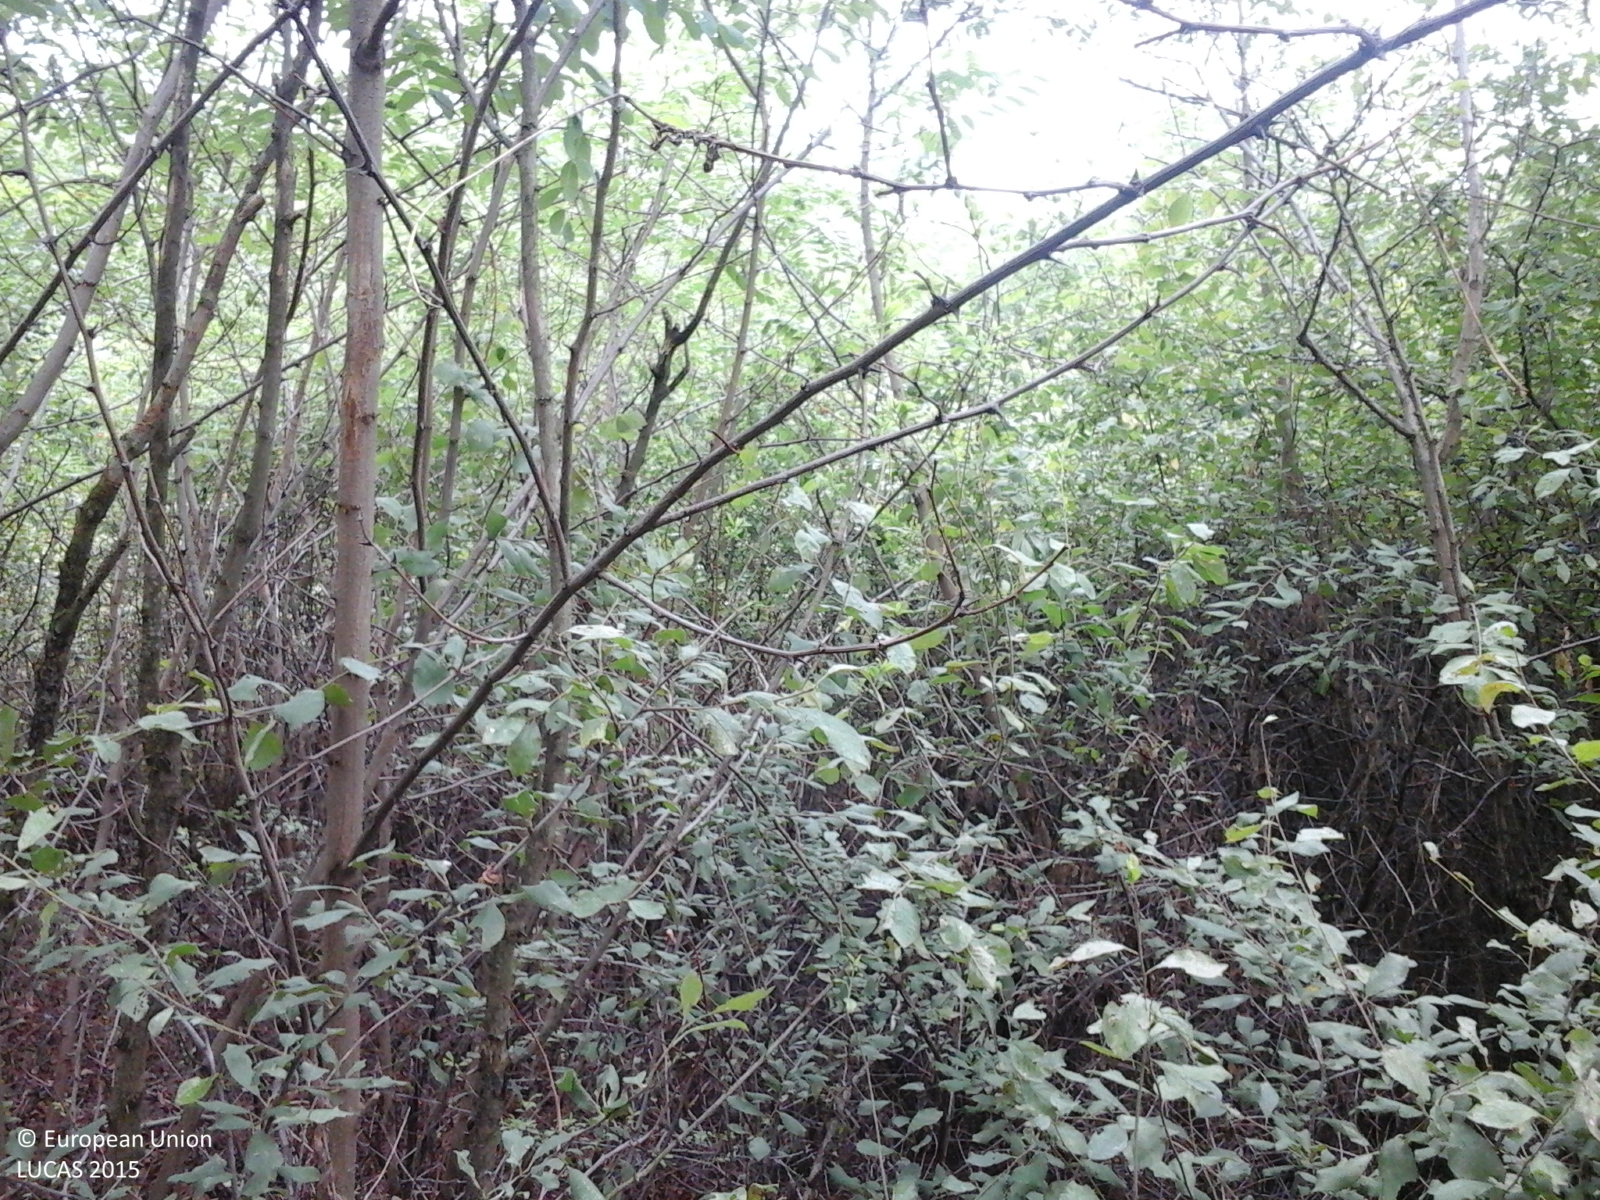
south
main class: Woodland
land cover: Broadleaved woodland
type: exotic forest
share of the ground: > 75 %
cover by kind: broadleaved forest trees 100 %
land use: Forestry
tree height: > 5 m
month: September
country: RO
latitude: 47.1697
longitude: 22.1211
